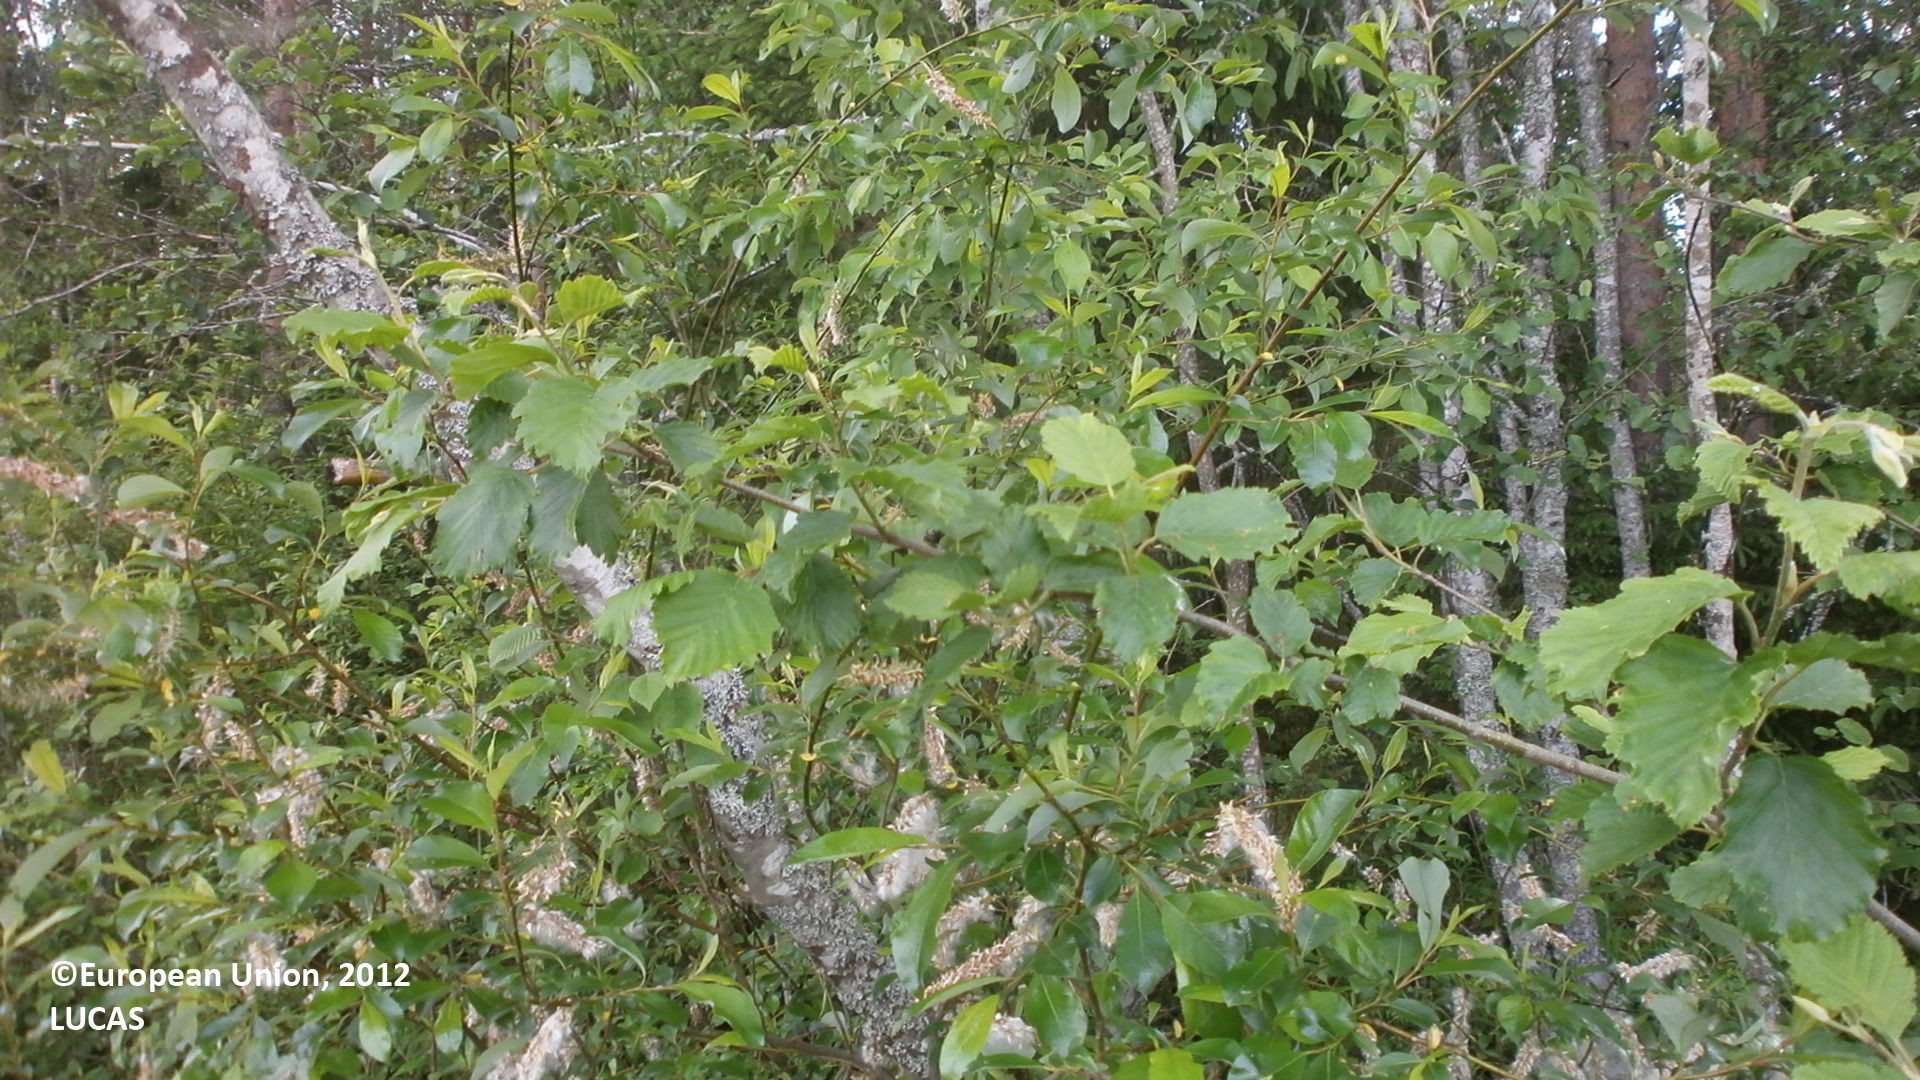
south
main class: Grassland
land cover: Grassland without tree/shrub cover
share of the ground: > 75 %
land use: Agriculture (excluding fallow land and kitchen gardens)
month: June
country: FI
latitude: 64.2303
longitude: 25.0291
